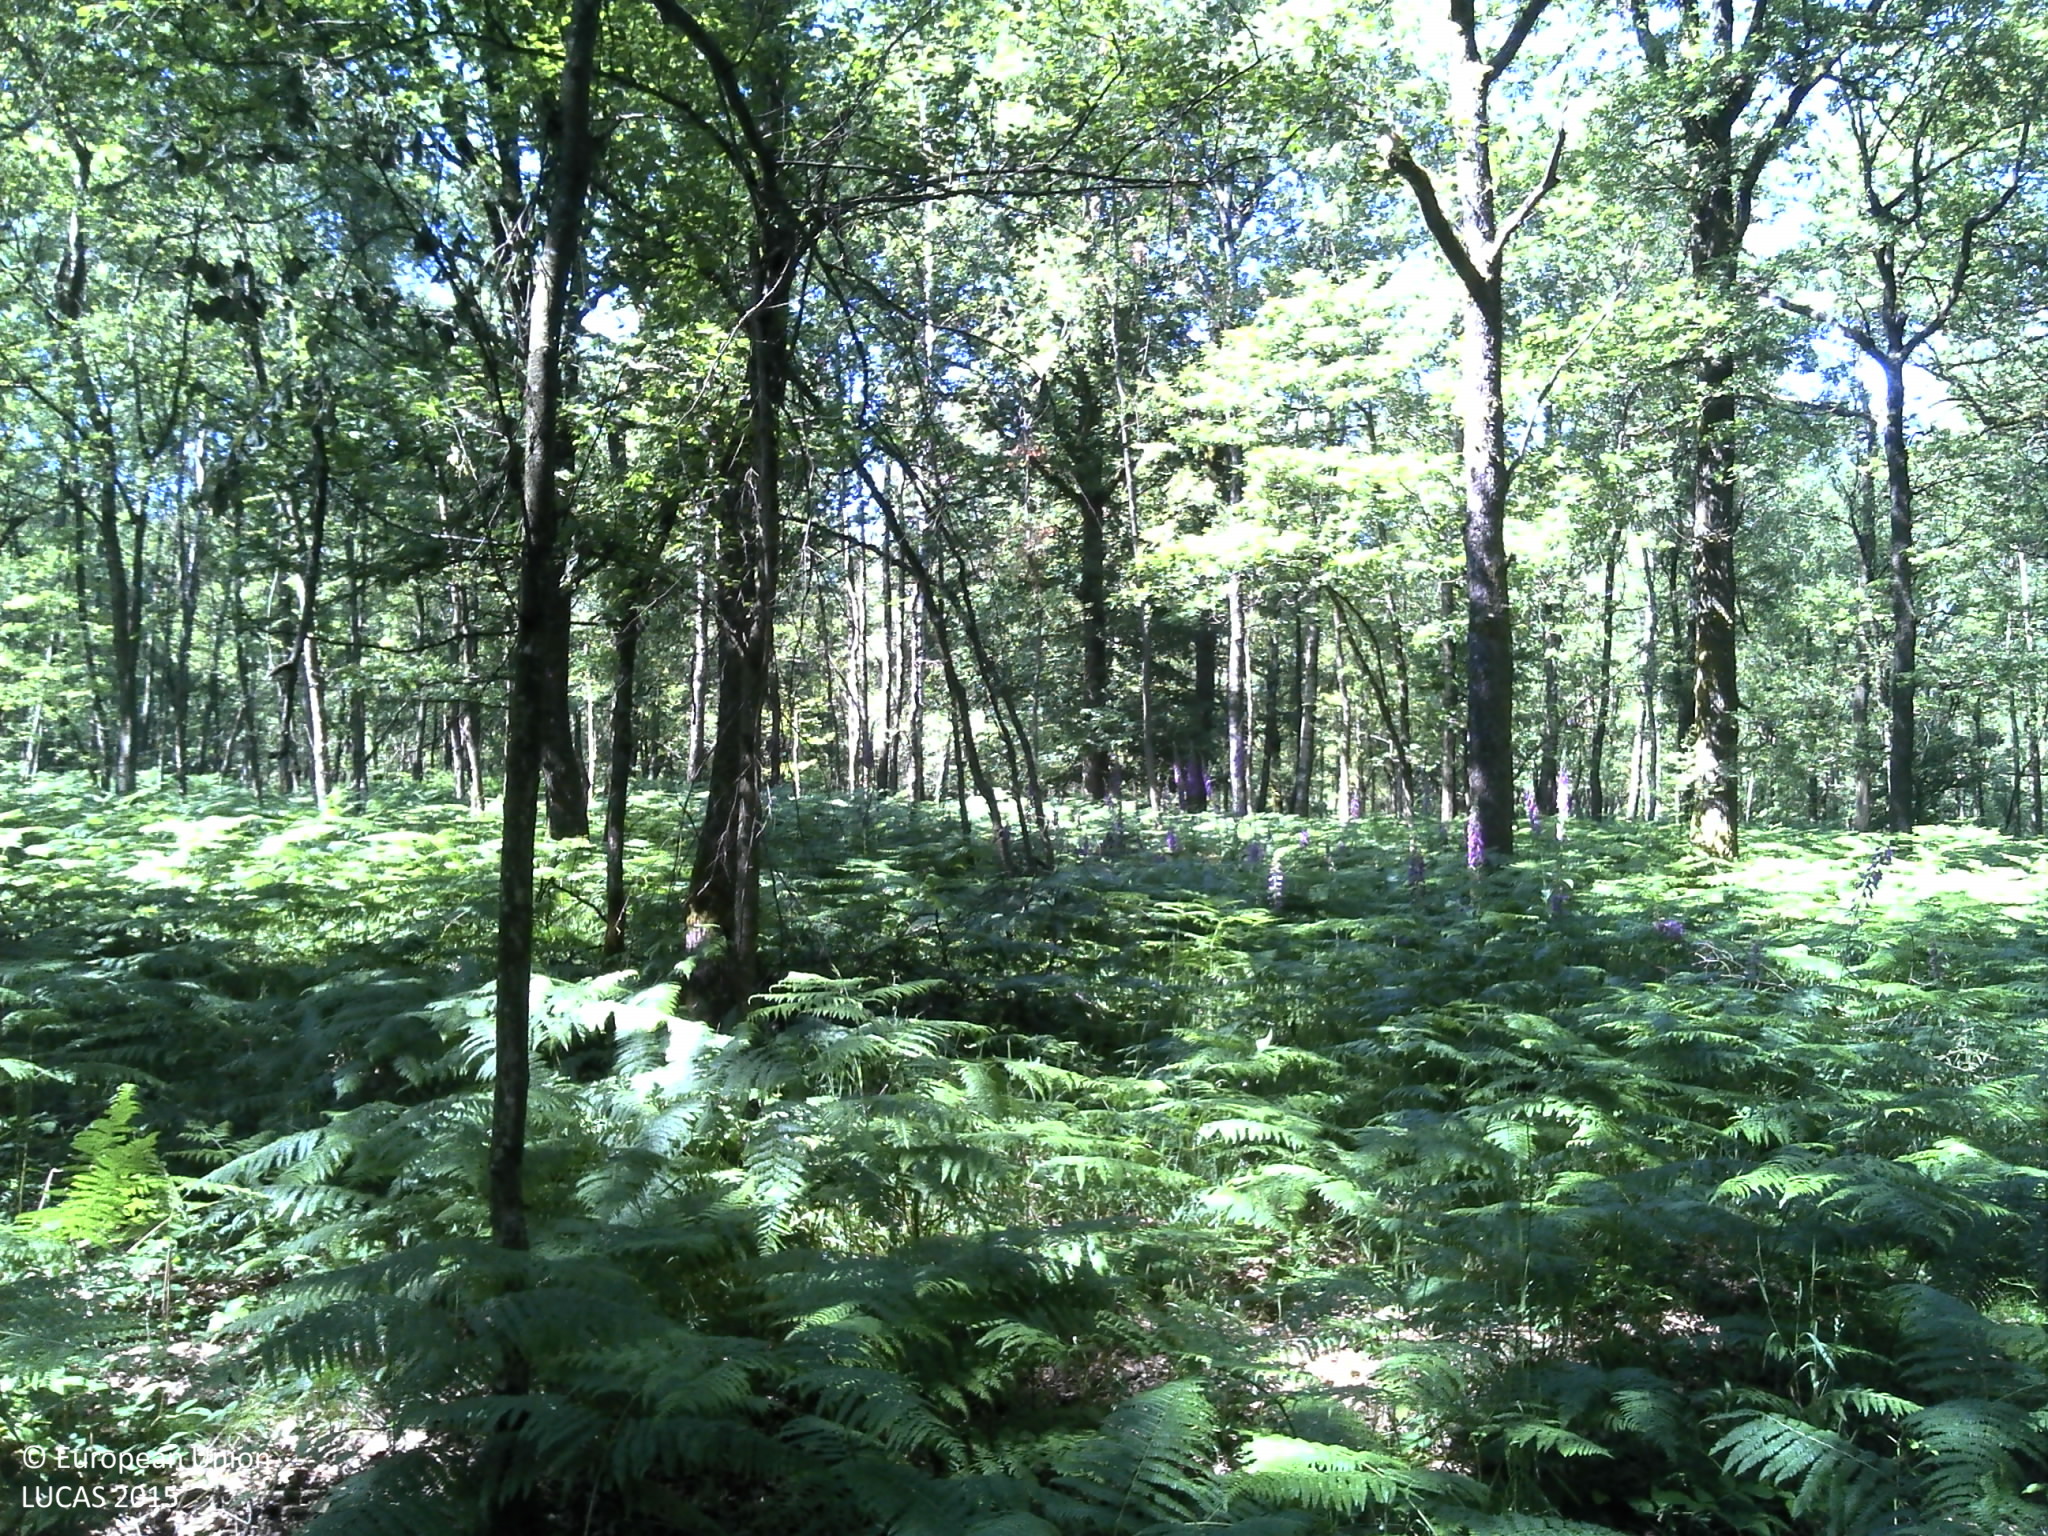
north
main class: Woodland
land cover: Broadleaved woodland
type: acidophilous oak and oak-birch forest
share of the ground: 25 - 50 %
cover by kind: broadleaved forest trees 65 %, herbaceous plants 25 %, consolidated bare surface 10 %
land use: Forestry
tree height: > 5 m
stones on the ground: 10 - 25 %
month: June
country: FR
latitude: 49.9933
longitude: 4.7938
